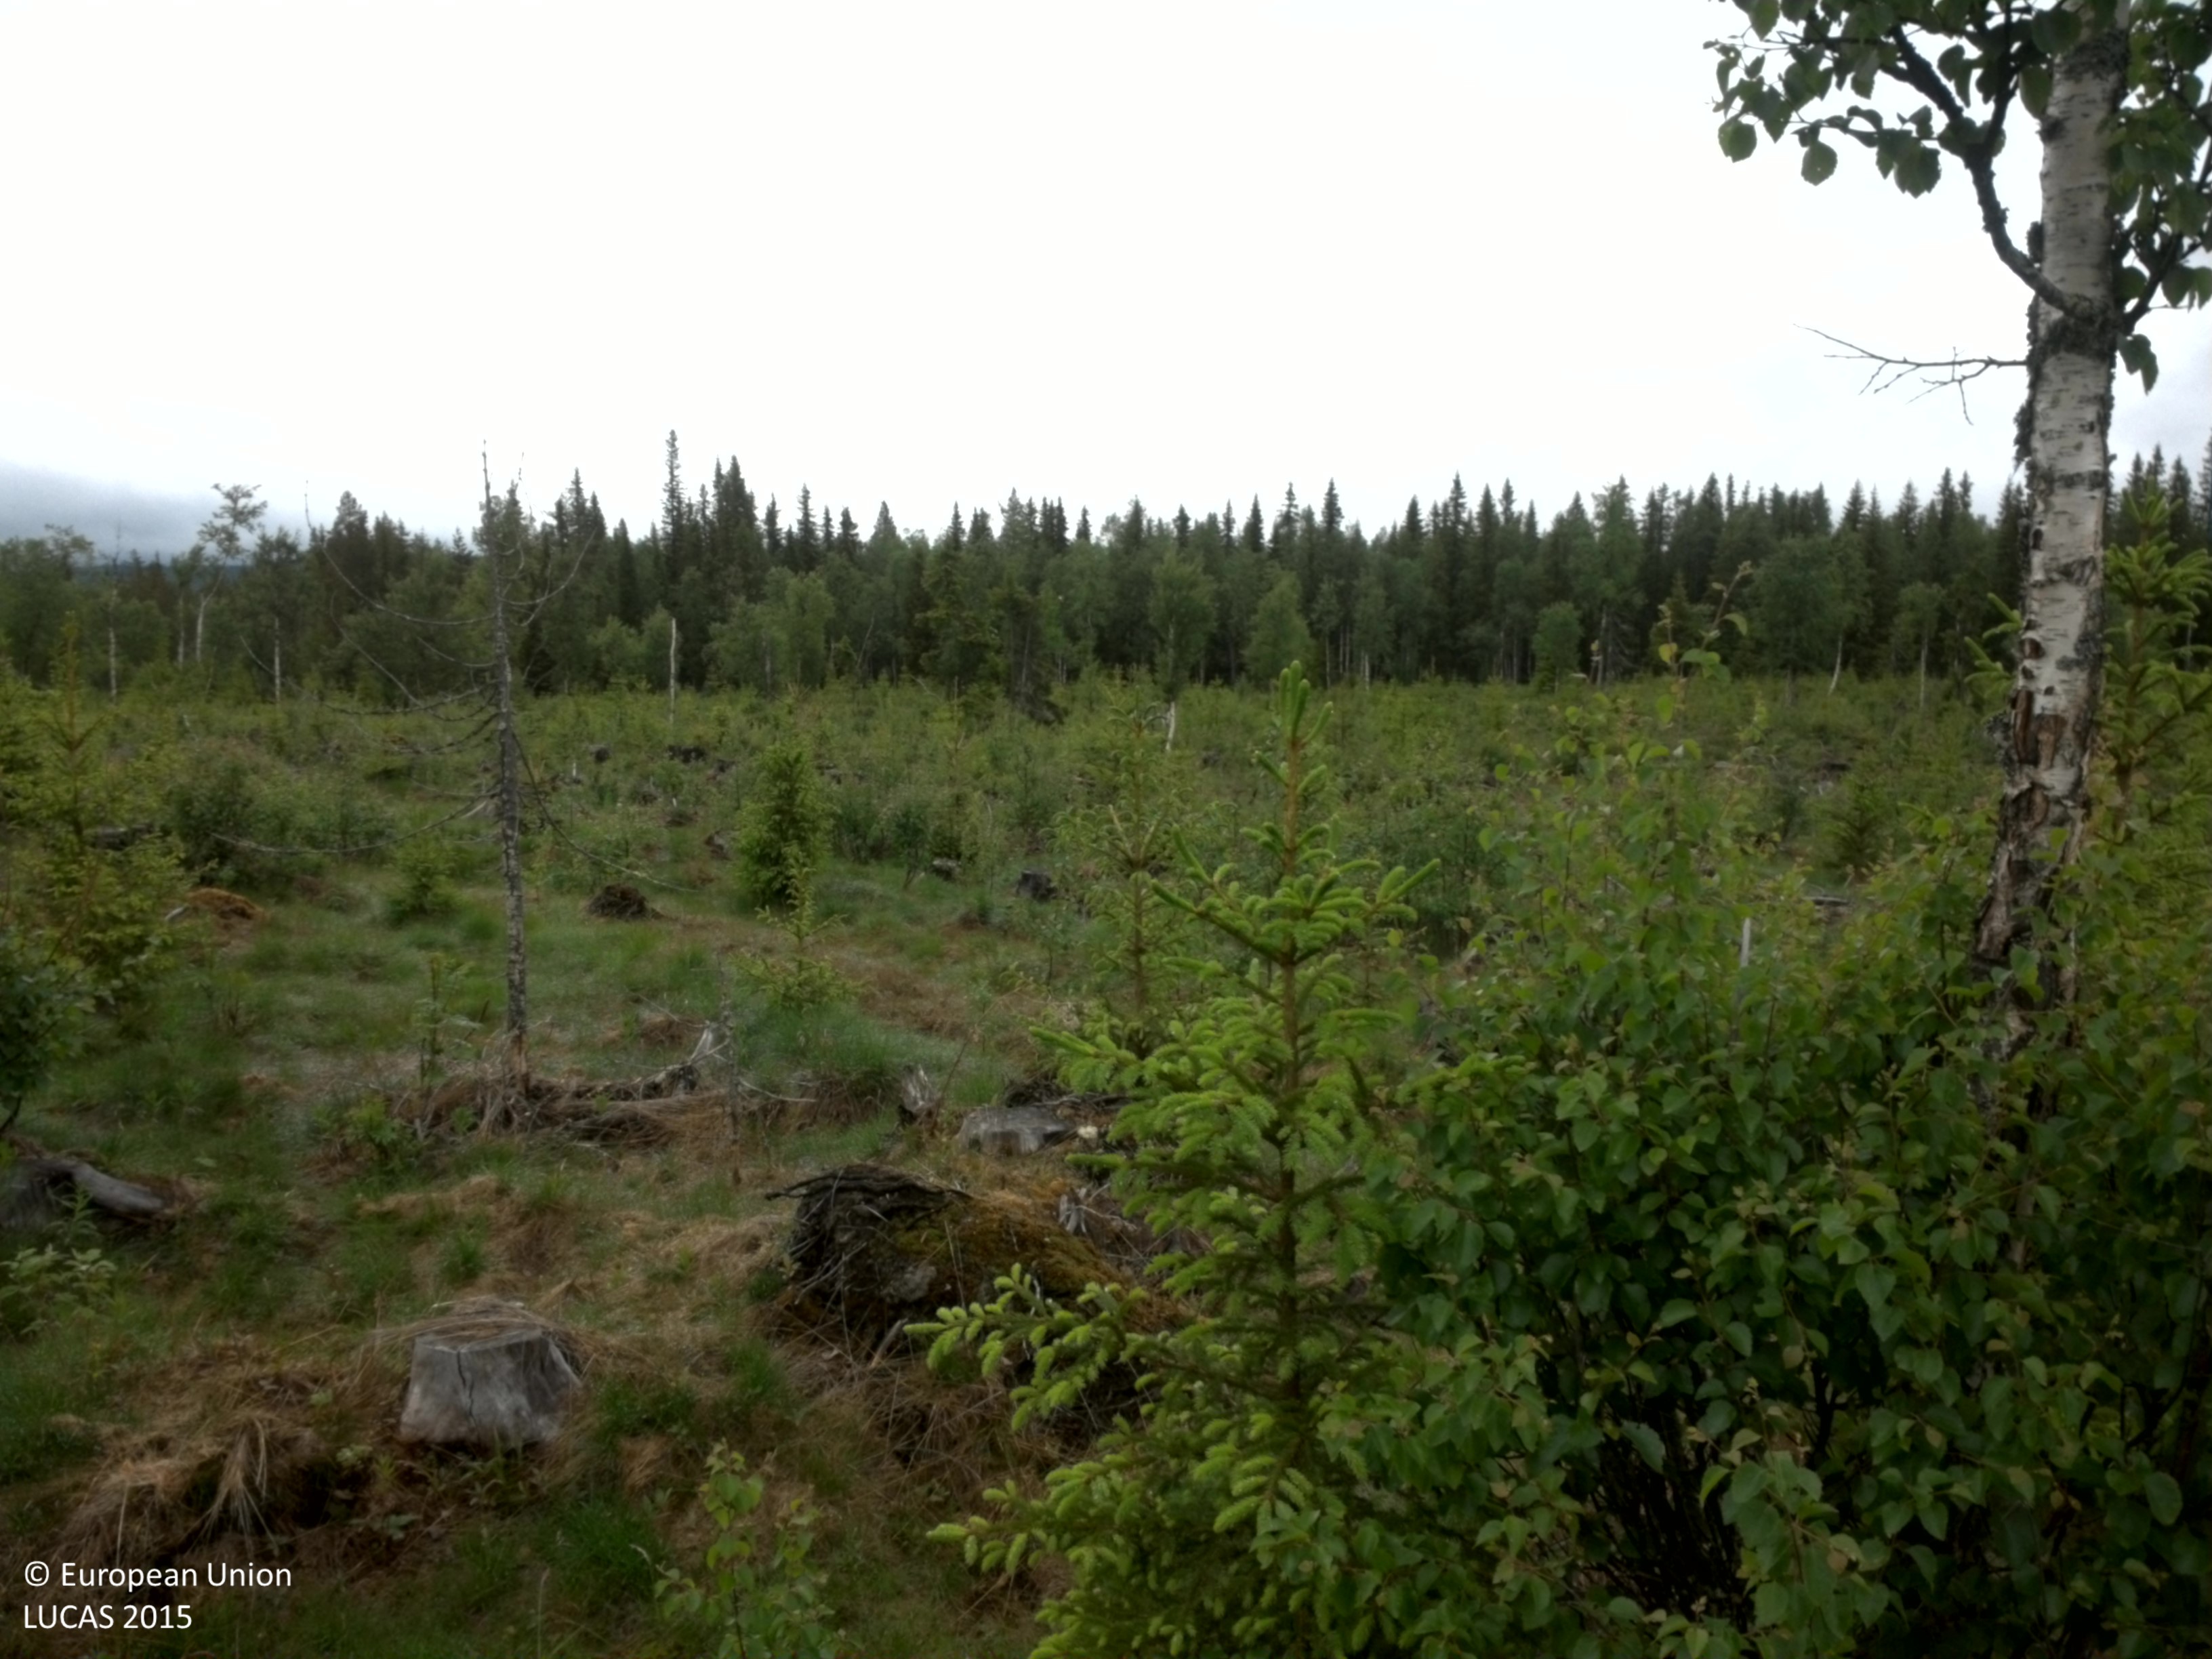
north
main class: Woodland
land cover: Spruce dominated mixed woodland
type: boreal forest
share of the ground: 10 - 25 %
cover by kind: coniferous forest trees 40 %, herbaceous plants 40 %, broadleaved forest trees 20 %
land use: Forestry
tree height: < 5 m
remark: Clear cut
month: July
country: SE
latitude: 64.4280
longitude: 18.0869
